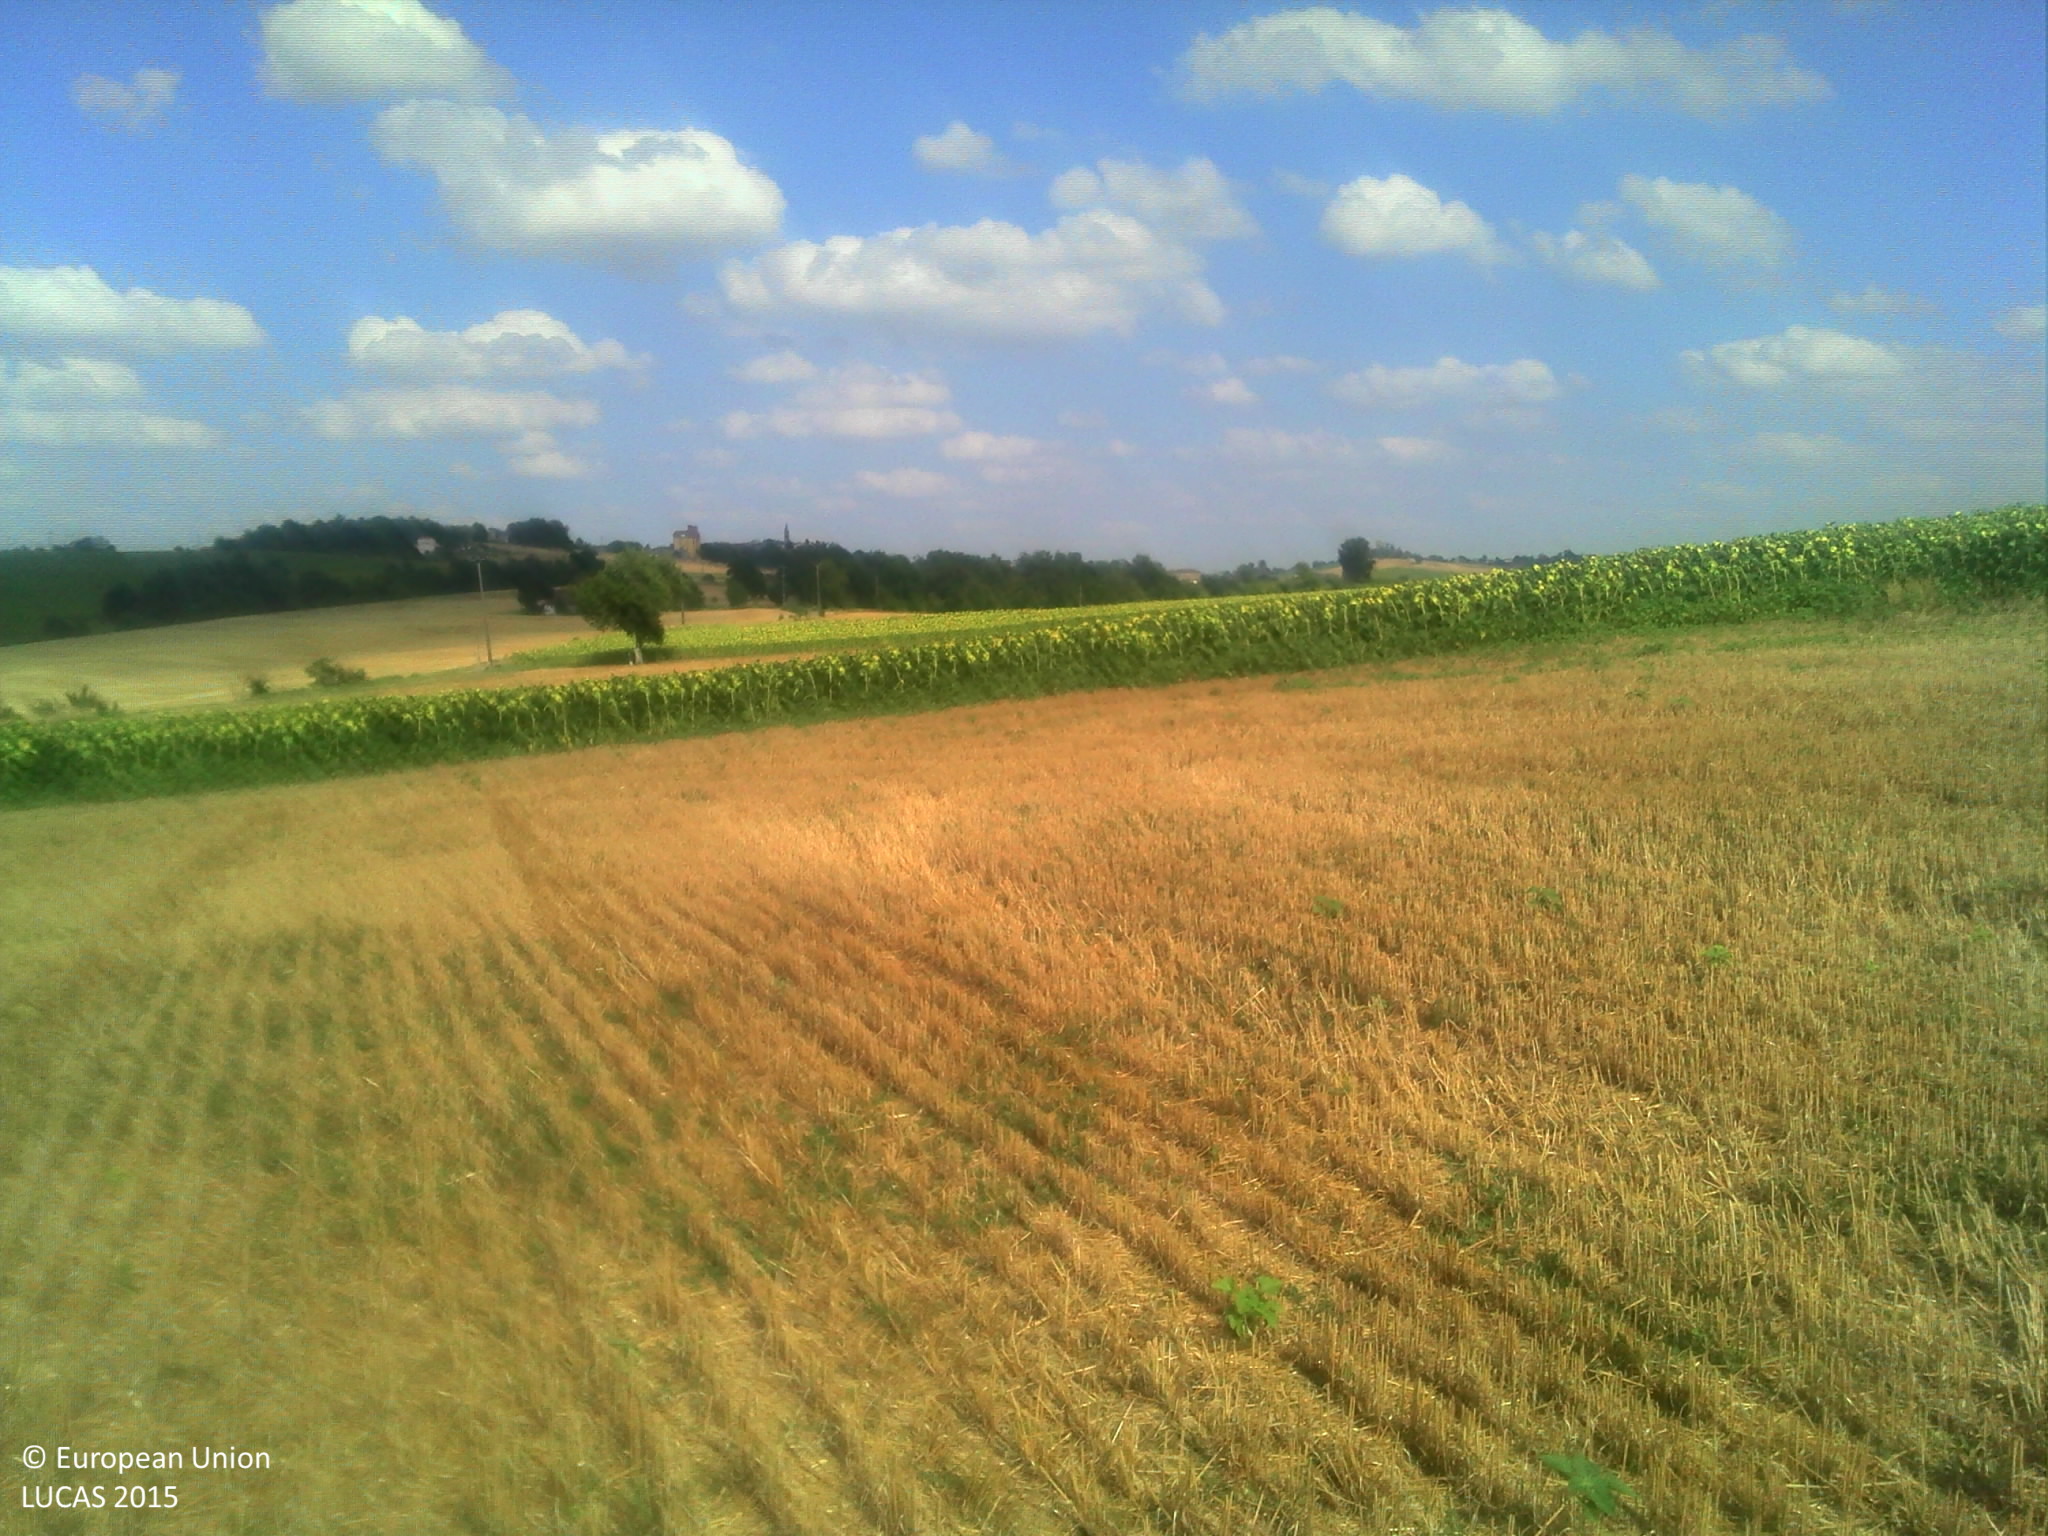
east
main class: Cropland
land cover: Common wheat
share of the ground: > 75 %
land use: Agriculture (excluding fallow land and kitchen gardens)
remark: Harvested field
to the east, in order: Common wheat; Sunflower; Other bare soil; Single bushes/trees; Grass margins; Paved roads, cycling and walking lanes; Grass margins; Sunflower
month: July
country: FR
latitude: 44.0163
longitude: 0.6276
